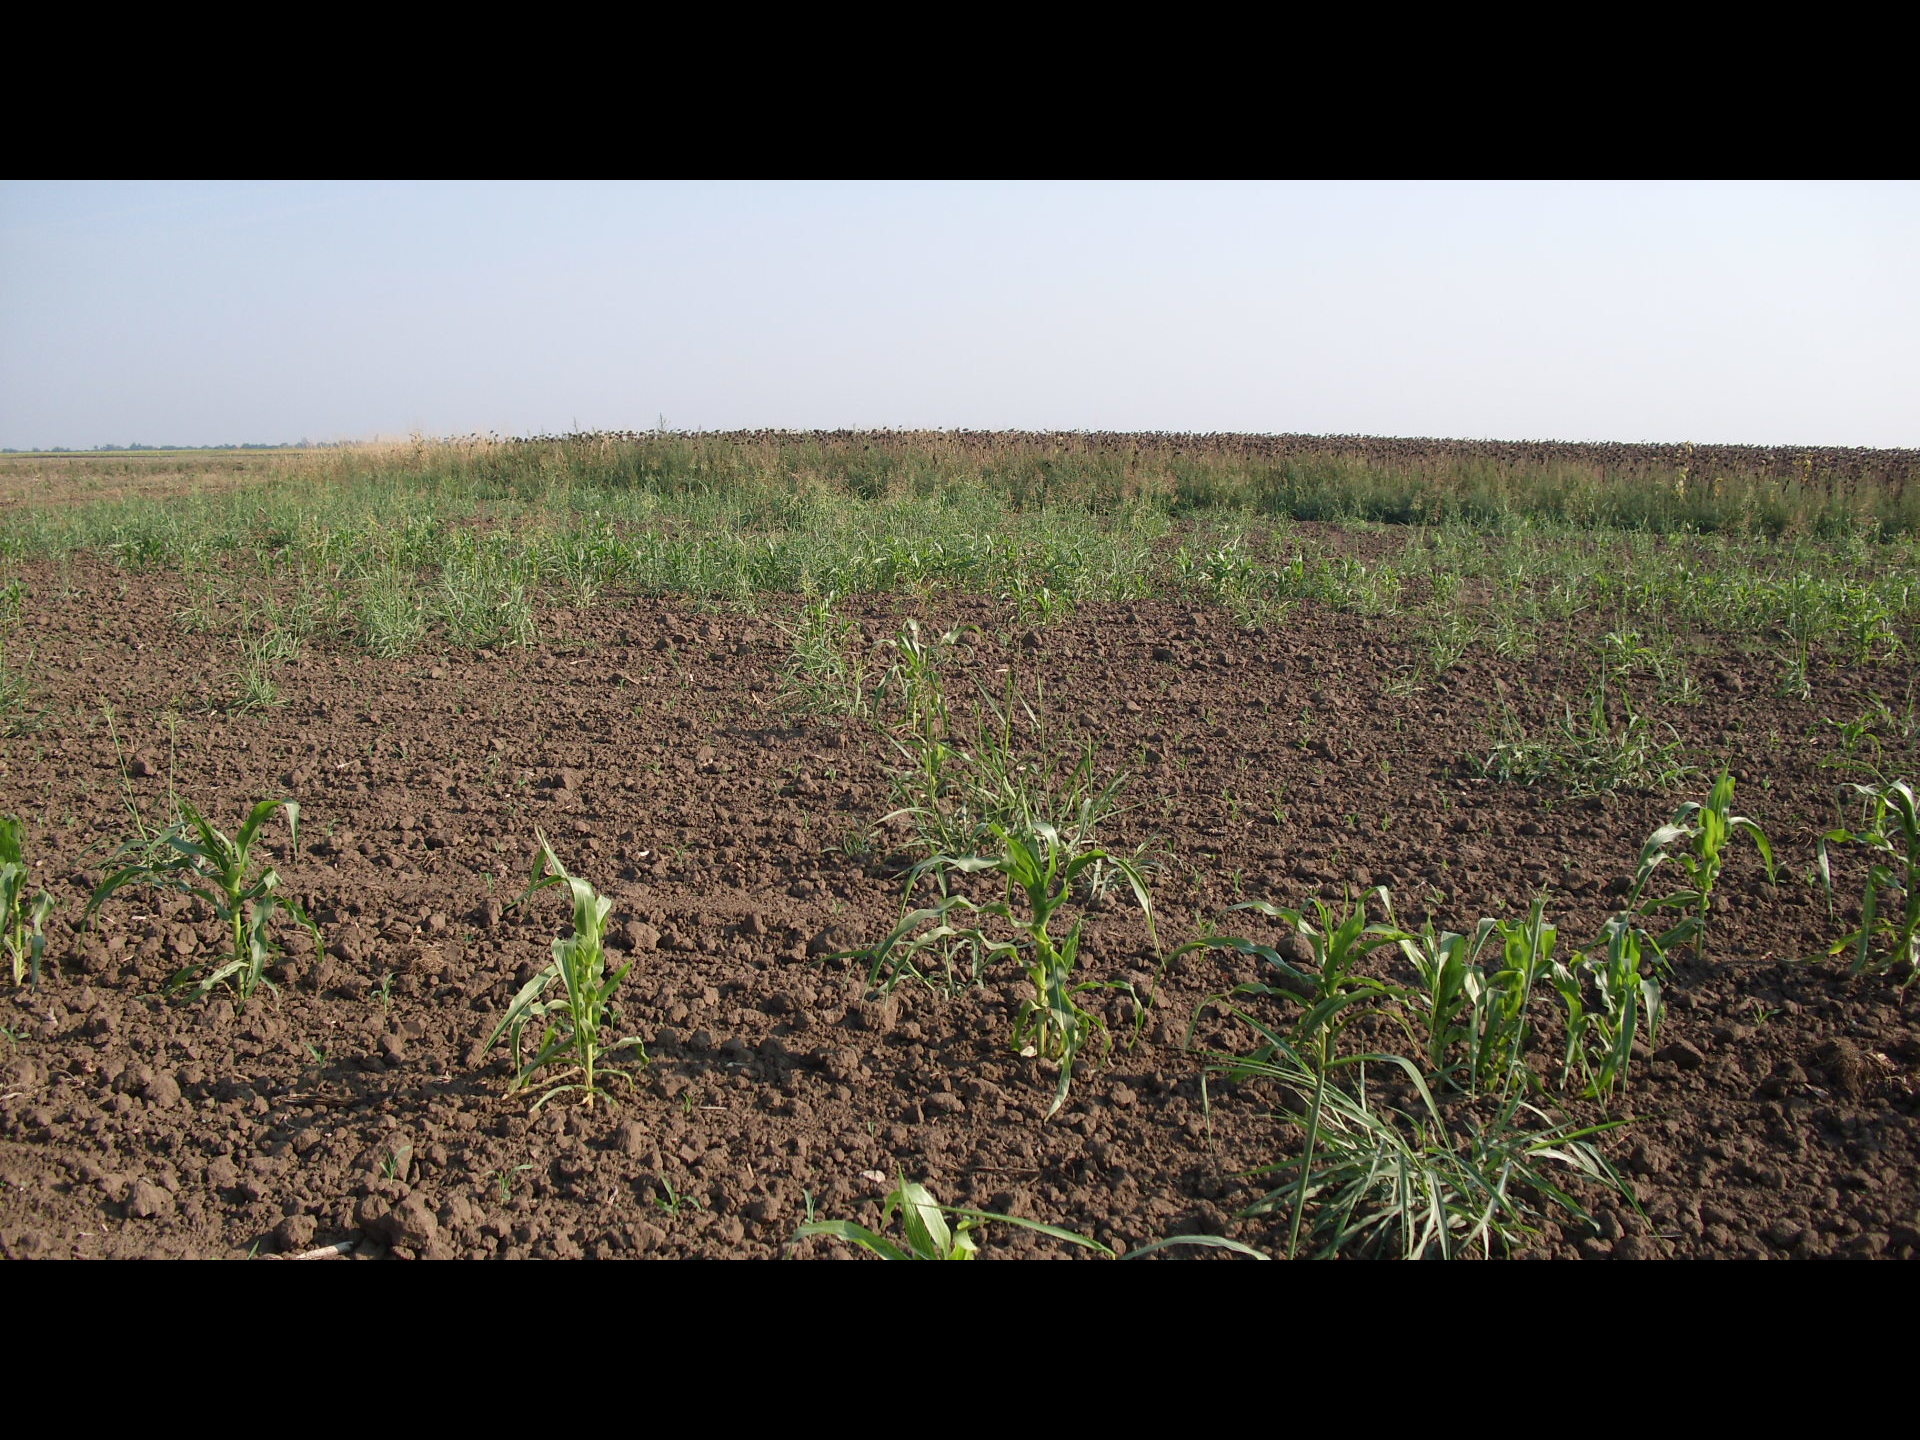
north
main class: Cropland
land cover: Maize
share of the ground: 25 - 50 %
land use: Agriculture (excluding fallow land and kitchen gardens)
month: August
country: BG
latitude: 44.0629
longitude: 22.9624
